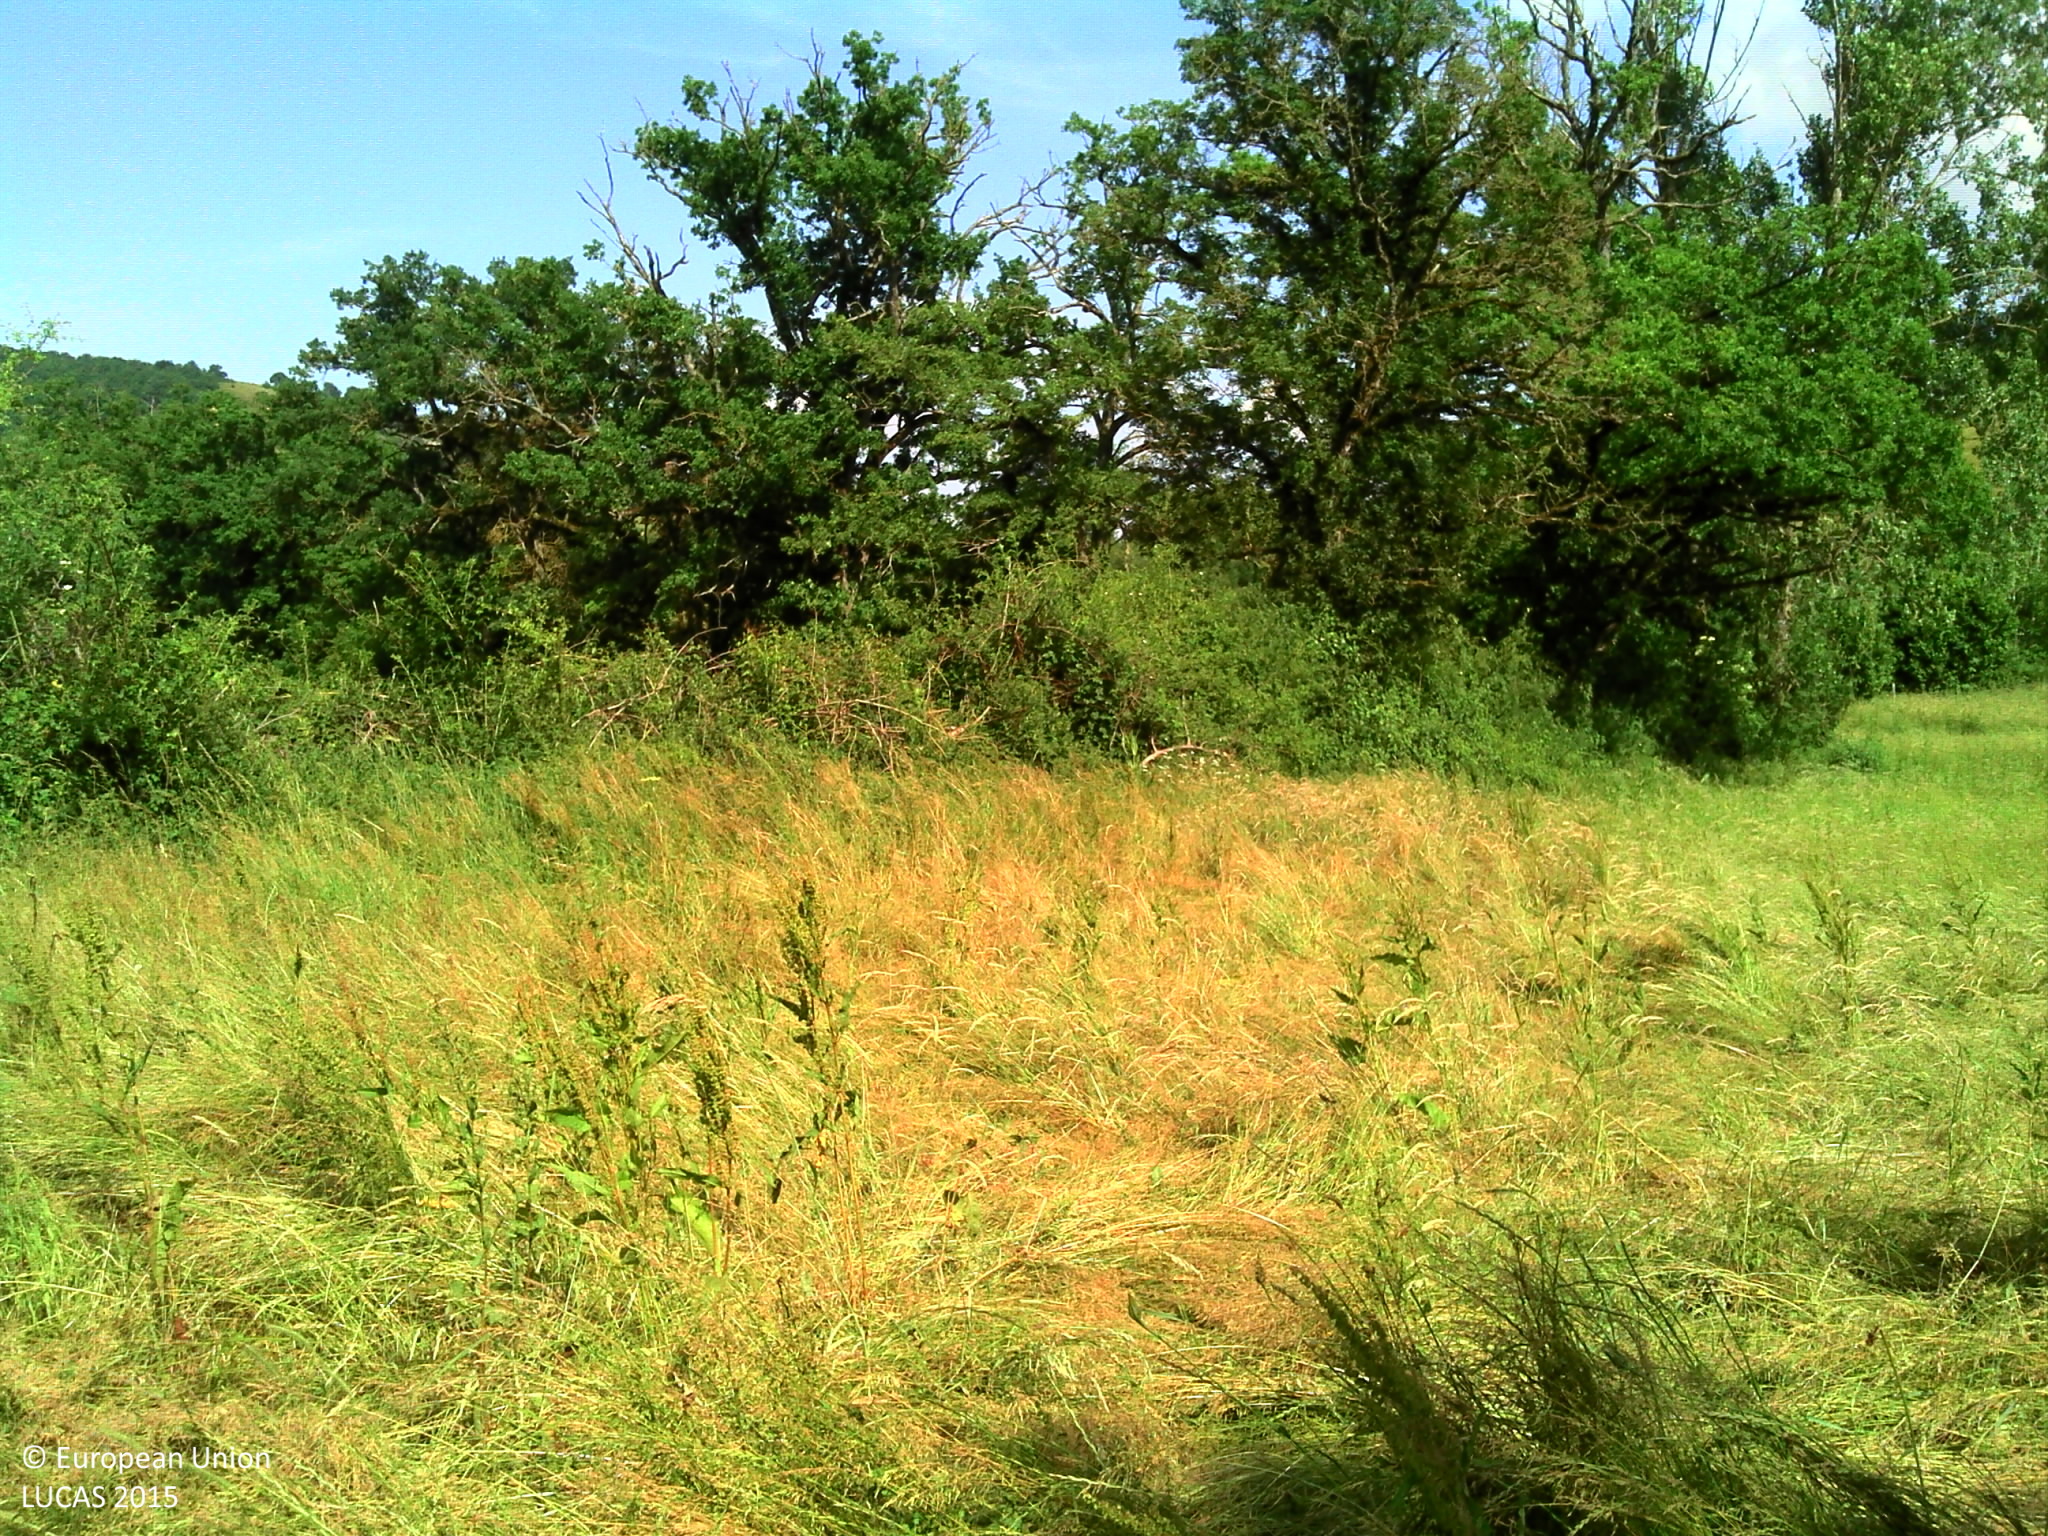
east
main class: Grassland
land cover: Grassland without tree/shrub cover
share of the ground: > 75 %
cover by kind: herbaceous plants 95 %, shrubs 5 %
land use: Agriculture (excluding fallow land and kitchen gardens)
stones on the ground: 10 - 25 %
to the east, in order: Grassland without tree/shrub cover; Broadleaved woodland; Fences; Grassland without tree/shrub cover; Fences; Broadleaved woodland; Rivers and streams; Grassland without tree/shrub cover; Ponds and wetlands; Fences; Abandoned hedges; Fences; Grassland without tree/shrub cover; Broadleaved woodland; Rivers and streams; Broadleaved woodland; Grassland without tree/shrub cover
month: June
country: FR
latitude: 44.3291
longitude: 2.9695
